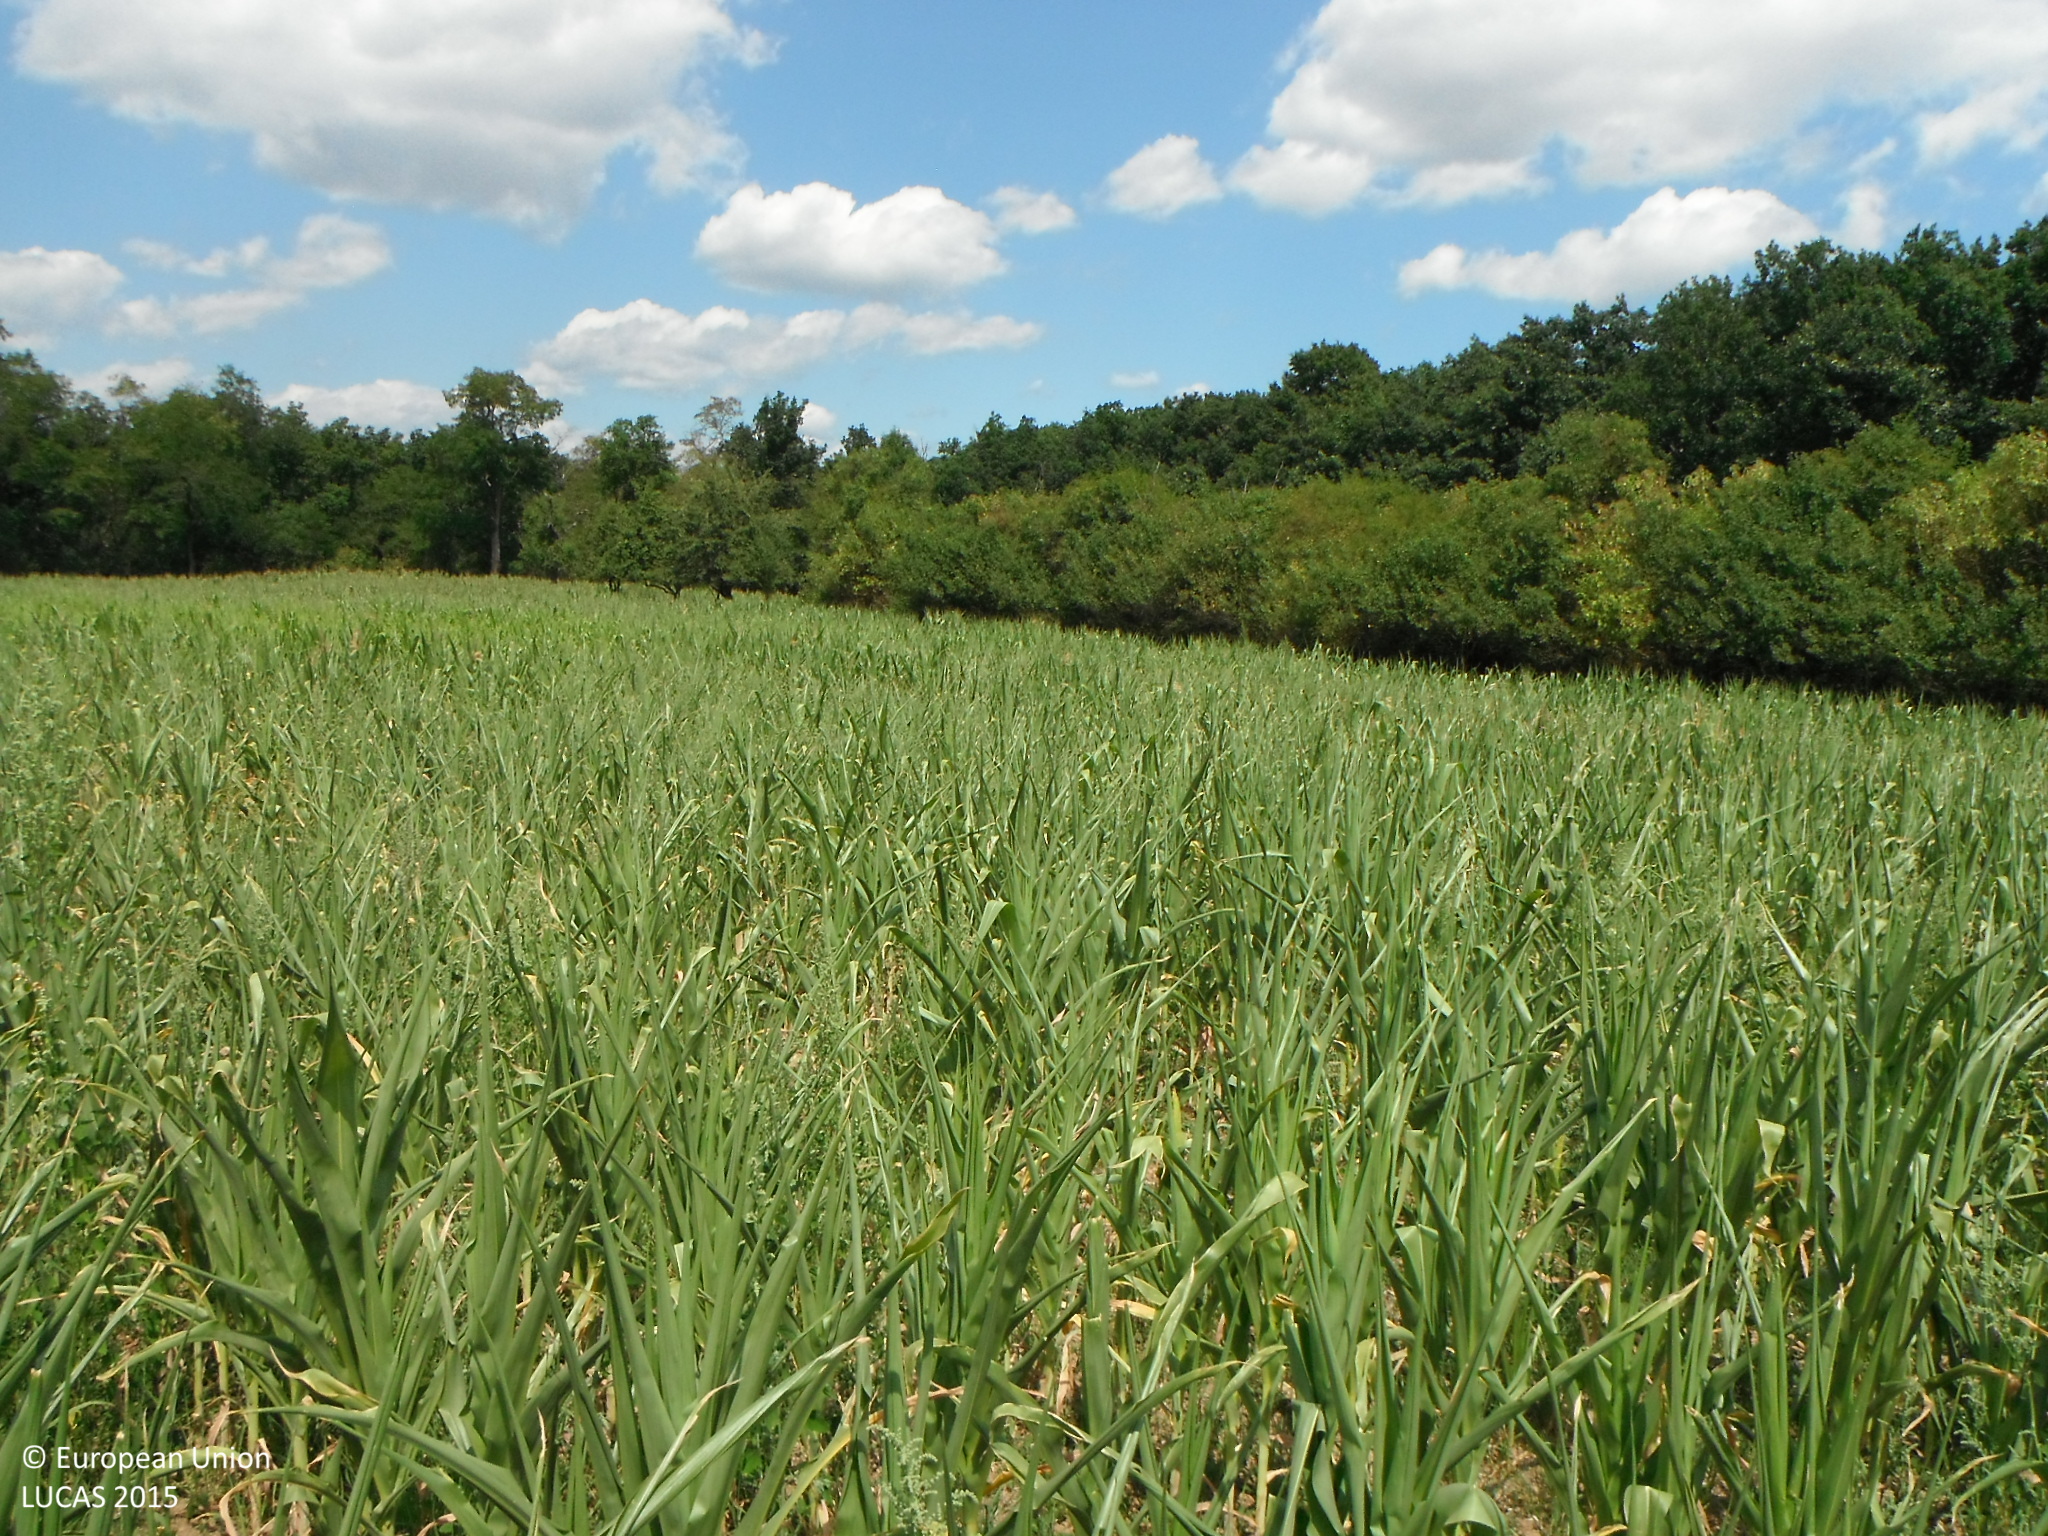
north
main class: Cropland
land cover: Maize
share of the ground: > 75 %
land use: Agriculture (excluding fallow land and kitchen gardens)
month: July
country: SK
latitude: 48.2975
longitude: 19.1201
